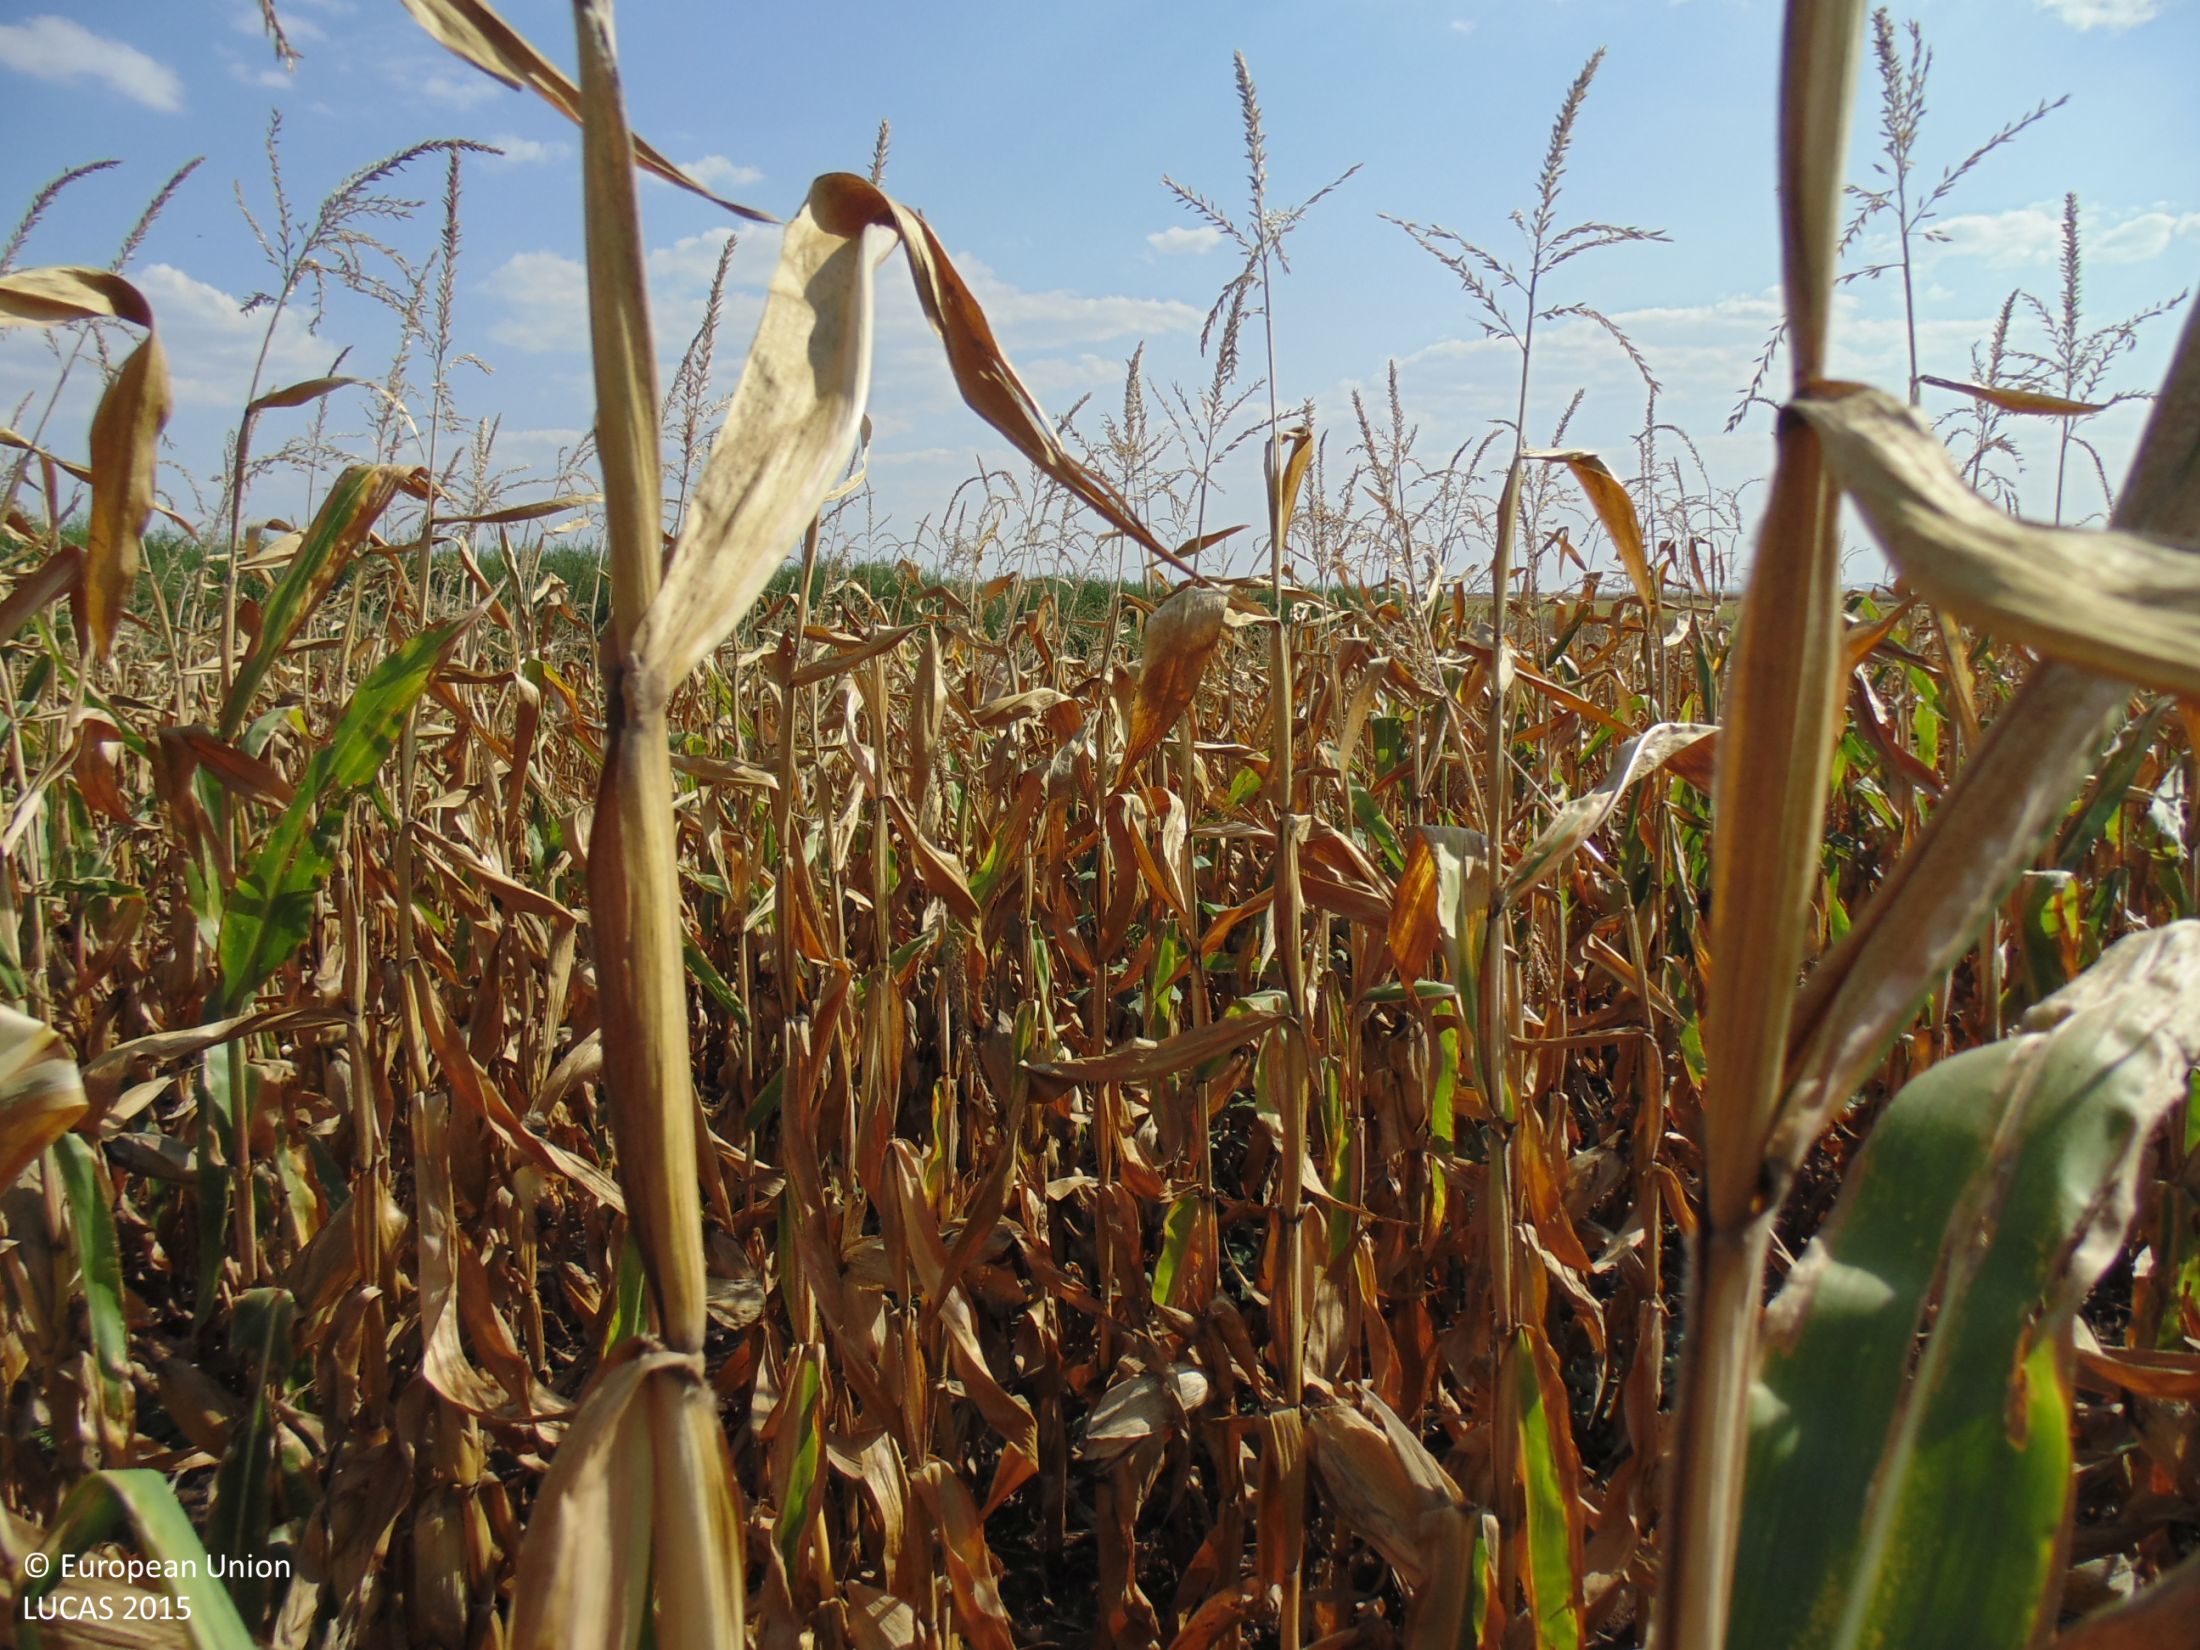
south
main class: Cropland
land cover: Maize
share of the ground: > 75 %
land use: Agriculture (excluding fallow land and kitchen gardens)
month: August
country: BG
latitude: 43.7046
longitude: 27.2389
